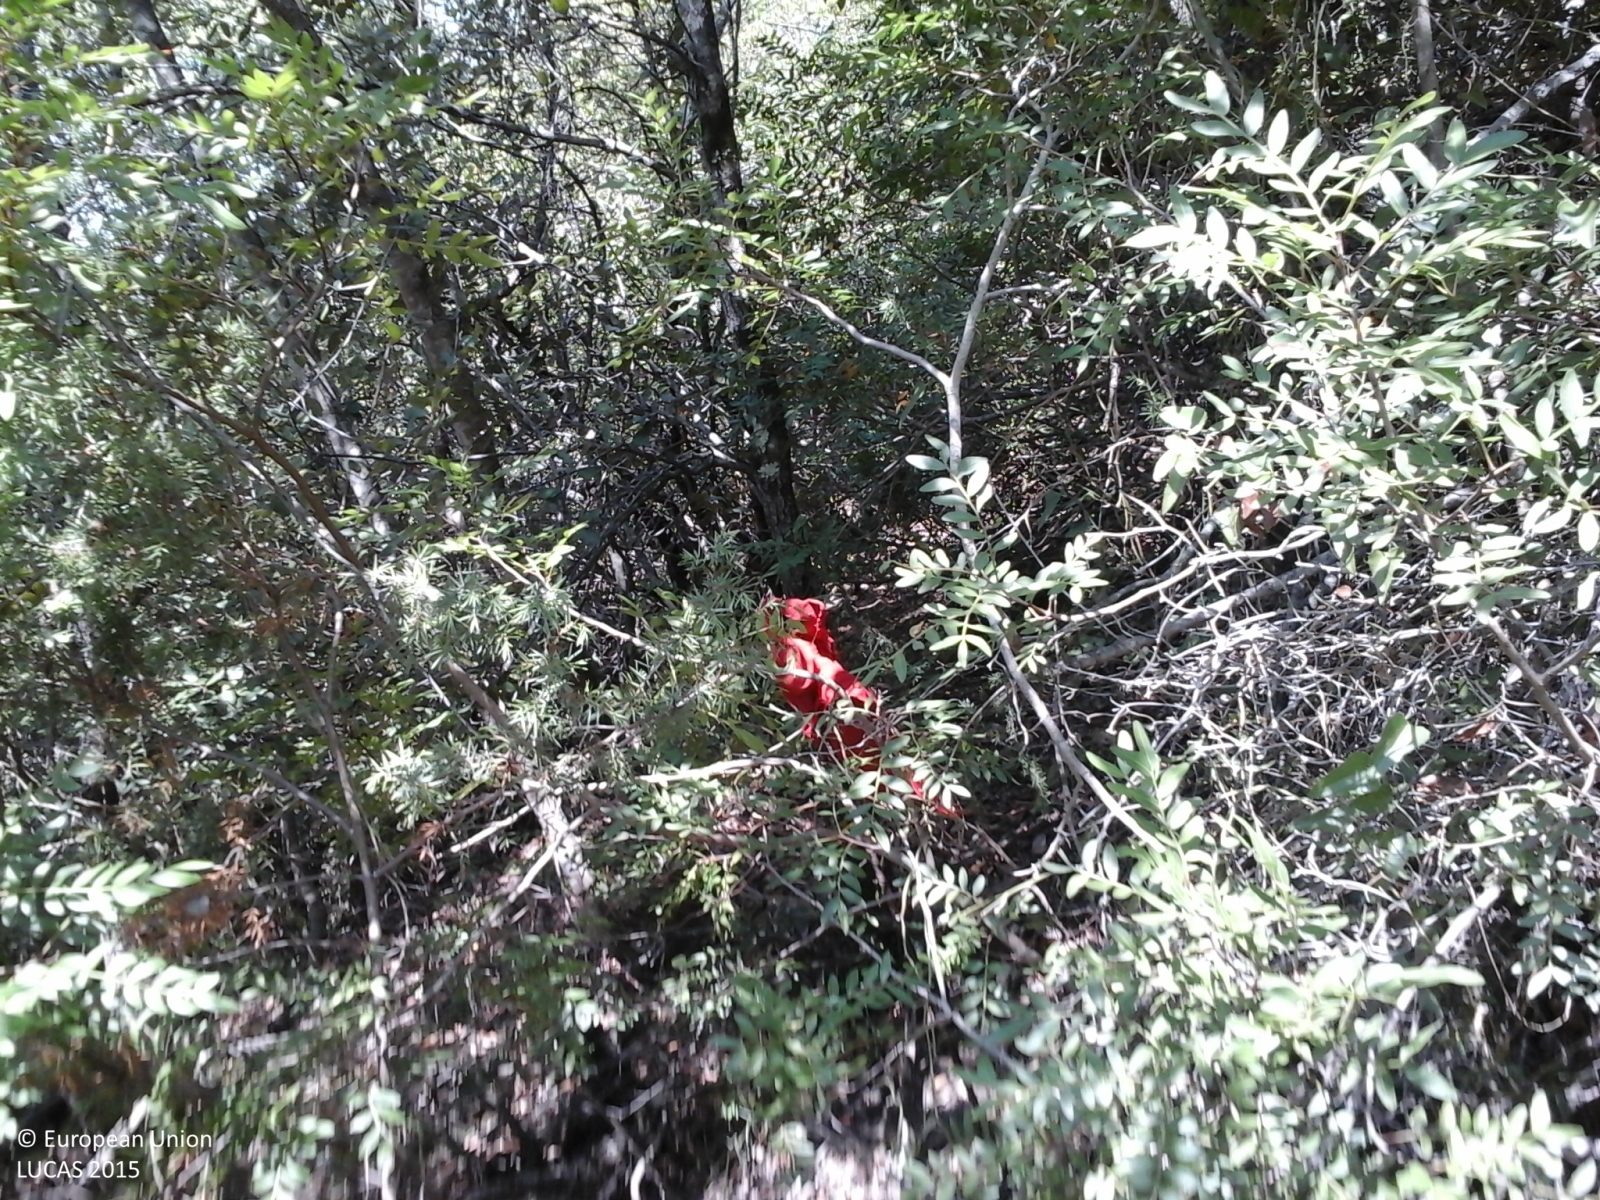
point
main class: Shrubland
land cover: Shrubland with sparse tree cover
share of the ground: > 75 %
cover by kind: shrubs 85 %, herbaceous plants 10 %, broadleaved forest trees 5 %
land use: Semi-natural and natural areas not in use
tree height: < 5 m
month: July
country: IT
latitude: 42.9672
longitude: 11.5522
